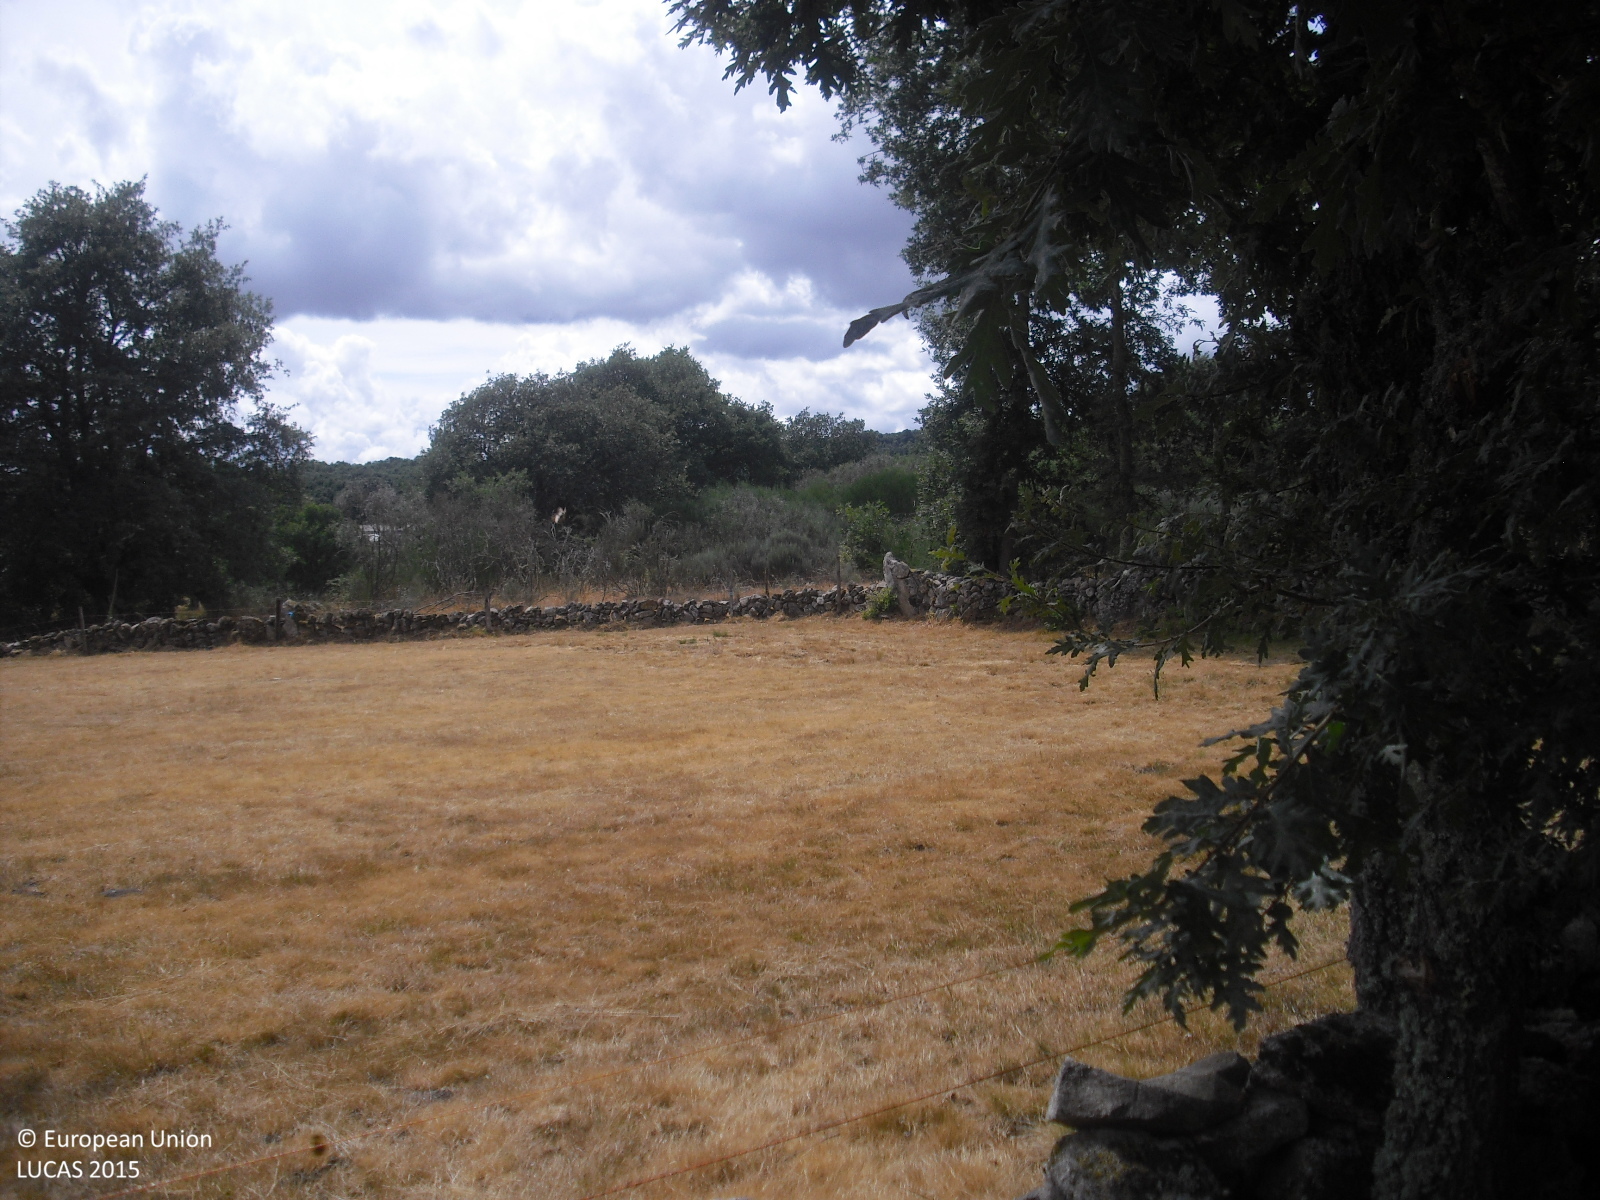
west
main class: Grassland
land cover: Grassland with sparse tree/shrub cover
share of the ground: > 75 %
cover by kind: herbaceous plants 95 %, broadleaved forest trees 5 %
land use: Abandoned areas
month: July
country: ES
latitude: 42.3486
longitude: -7.4118
